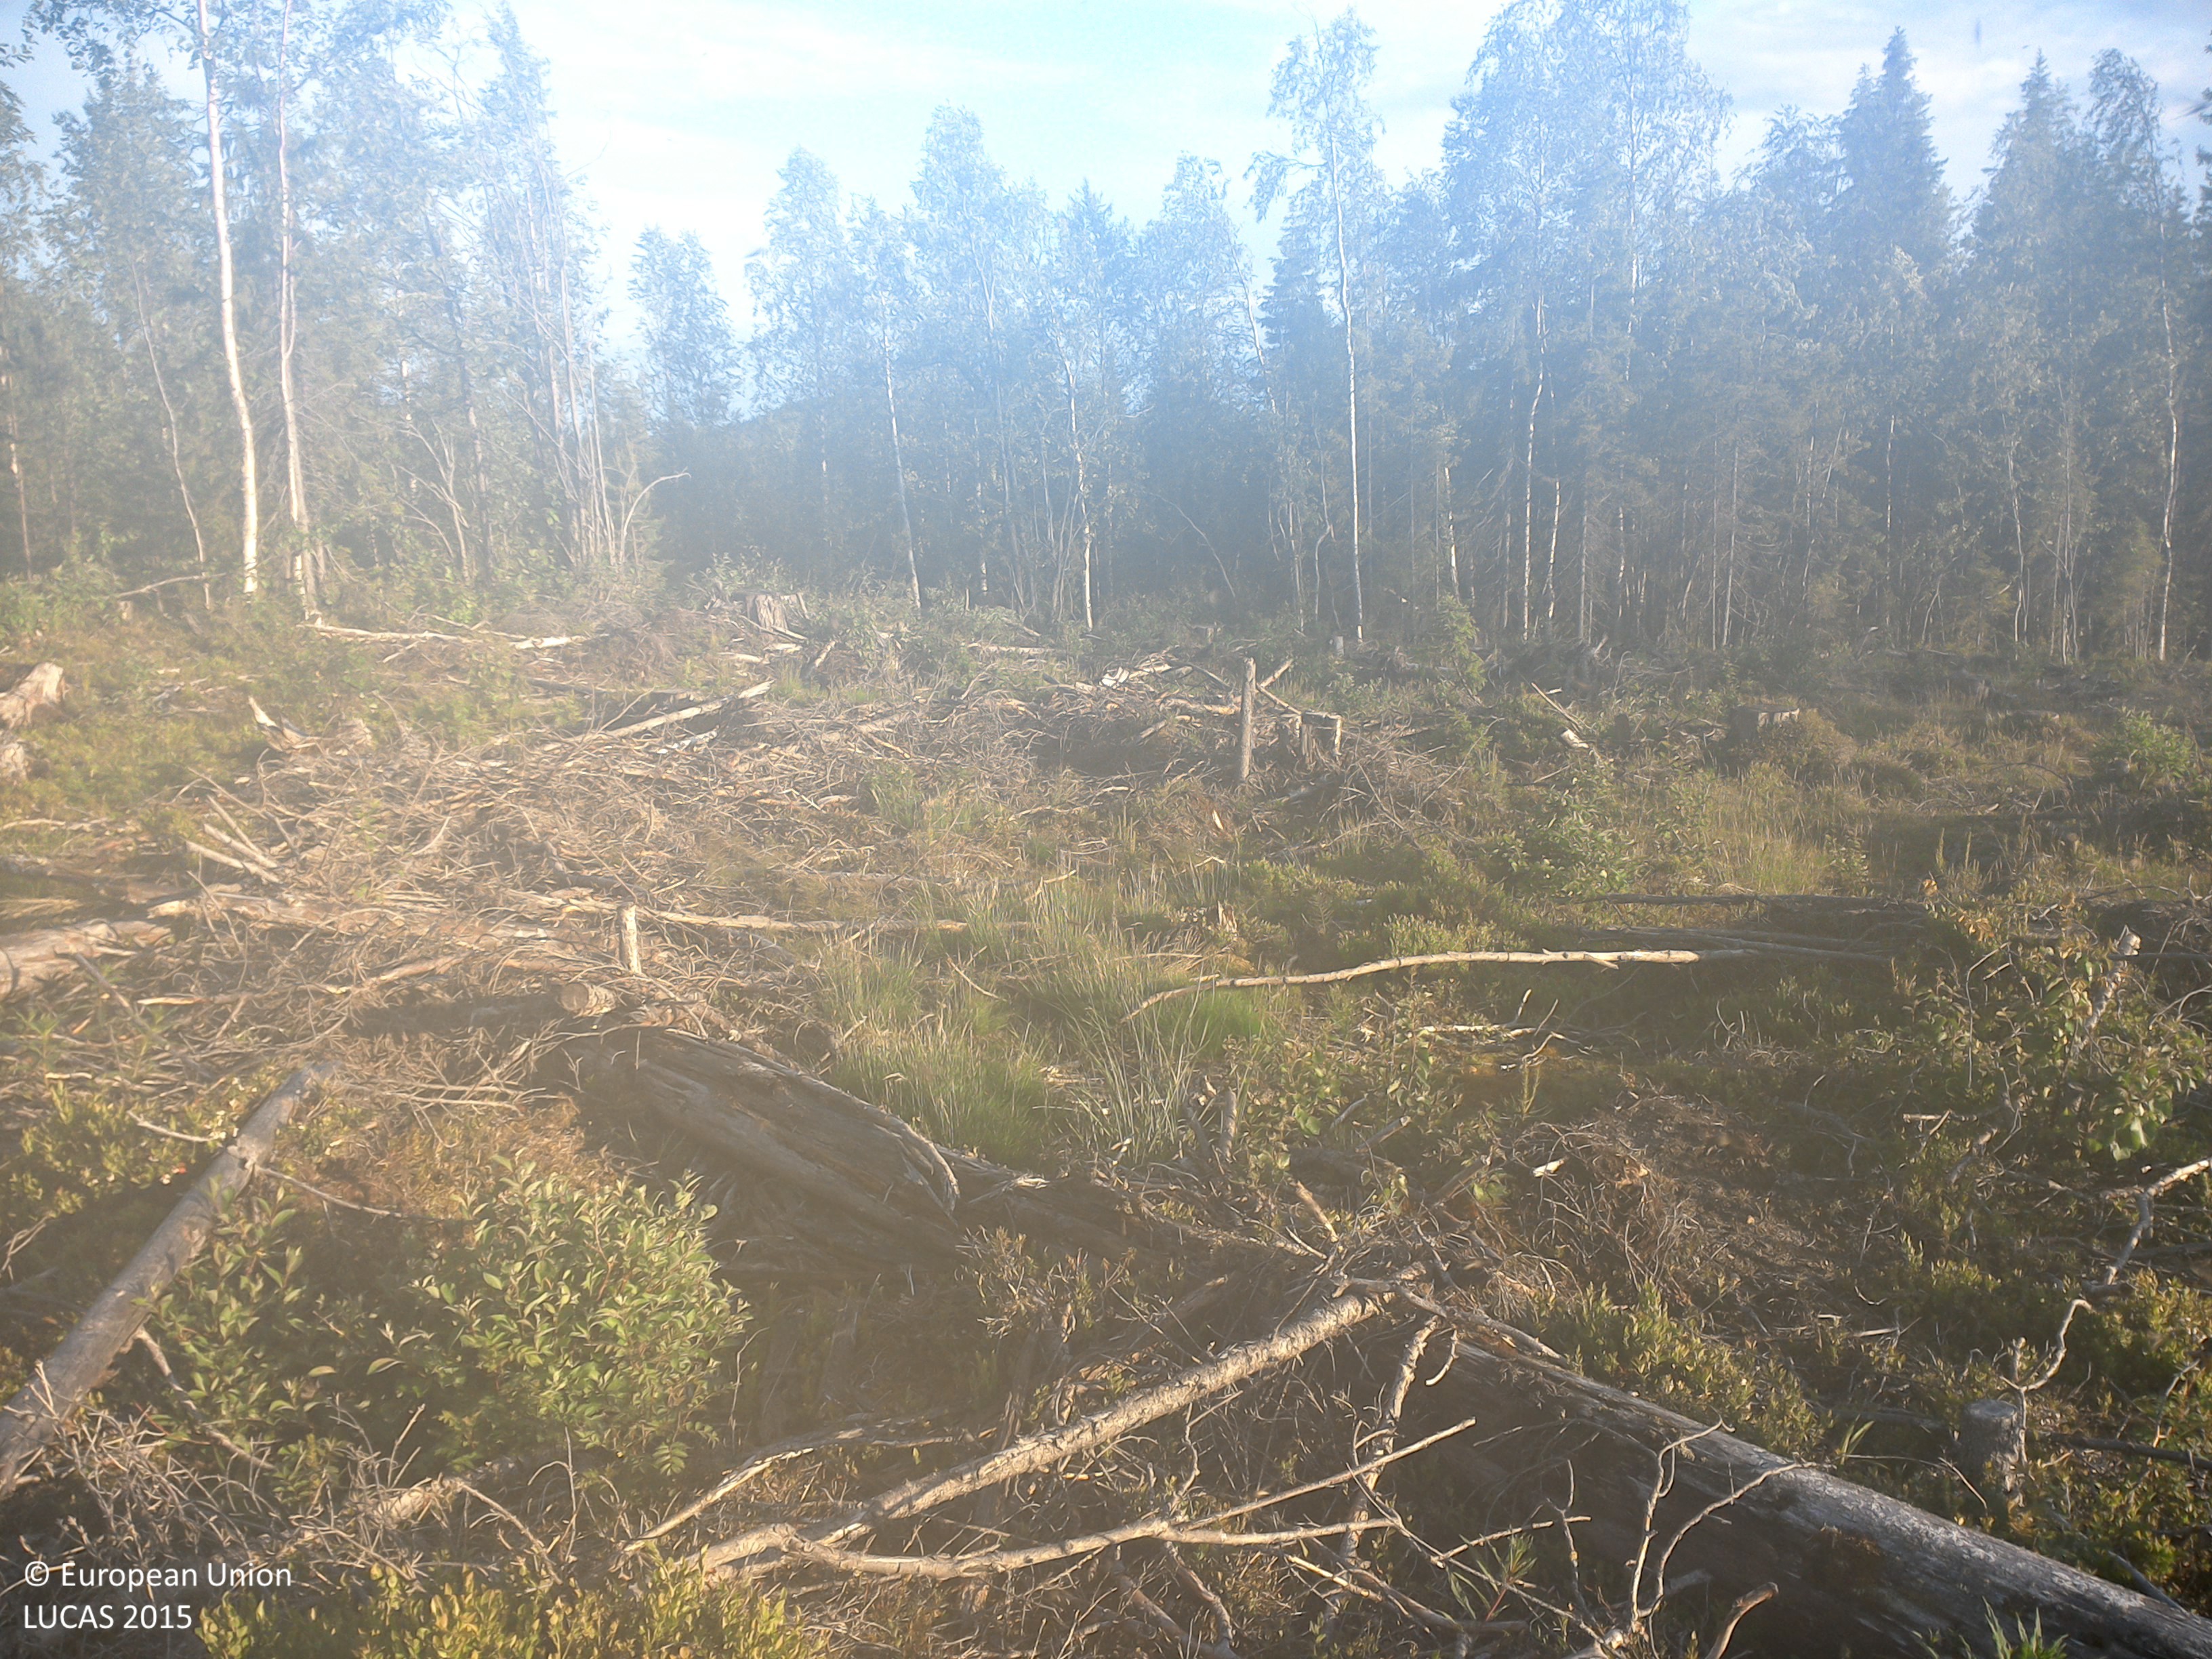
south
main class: Shrubland
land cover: Shrubland with sparse tree cover
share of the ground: 10 - 25 %
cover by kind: unconsolidated bare surface 45 %, shrubs 25 %, herbaceous plants 25 %, broadleaved forest trees 5 %
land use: Forestry
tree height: < 5 m
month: July
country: SE
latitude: 66.8864
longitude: 23.0994
